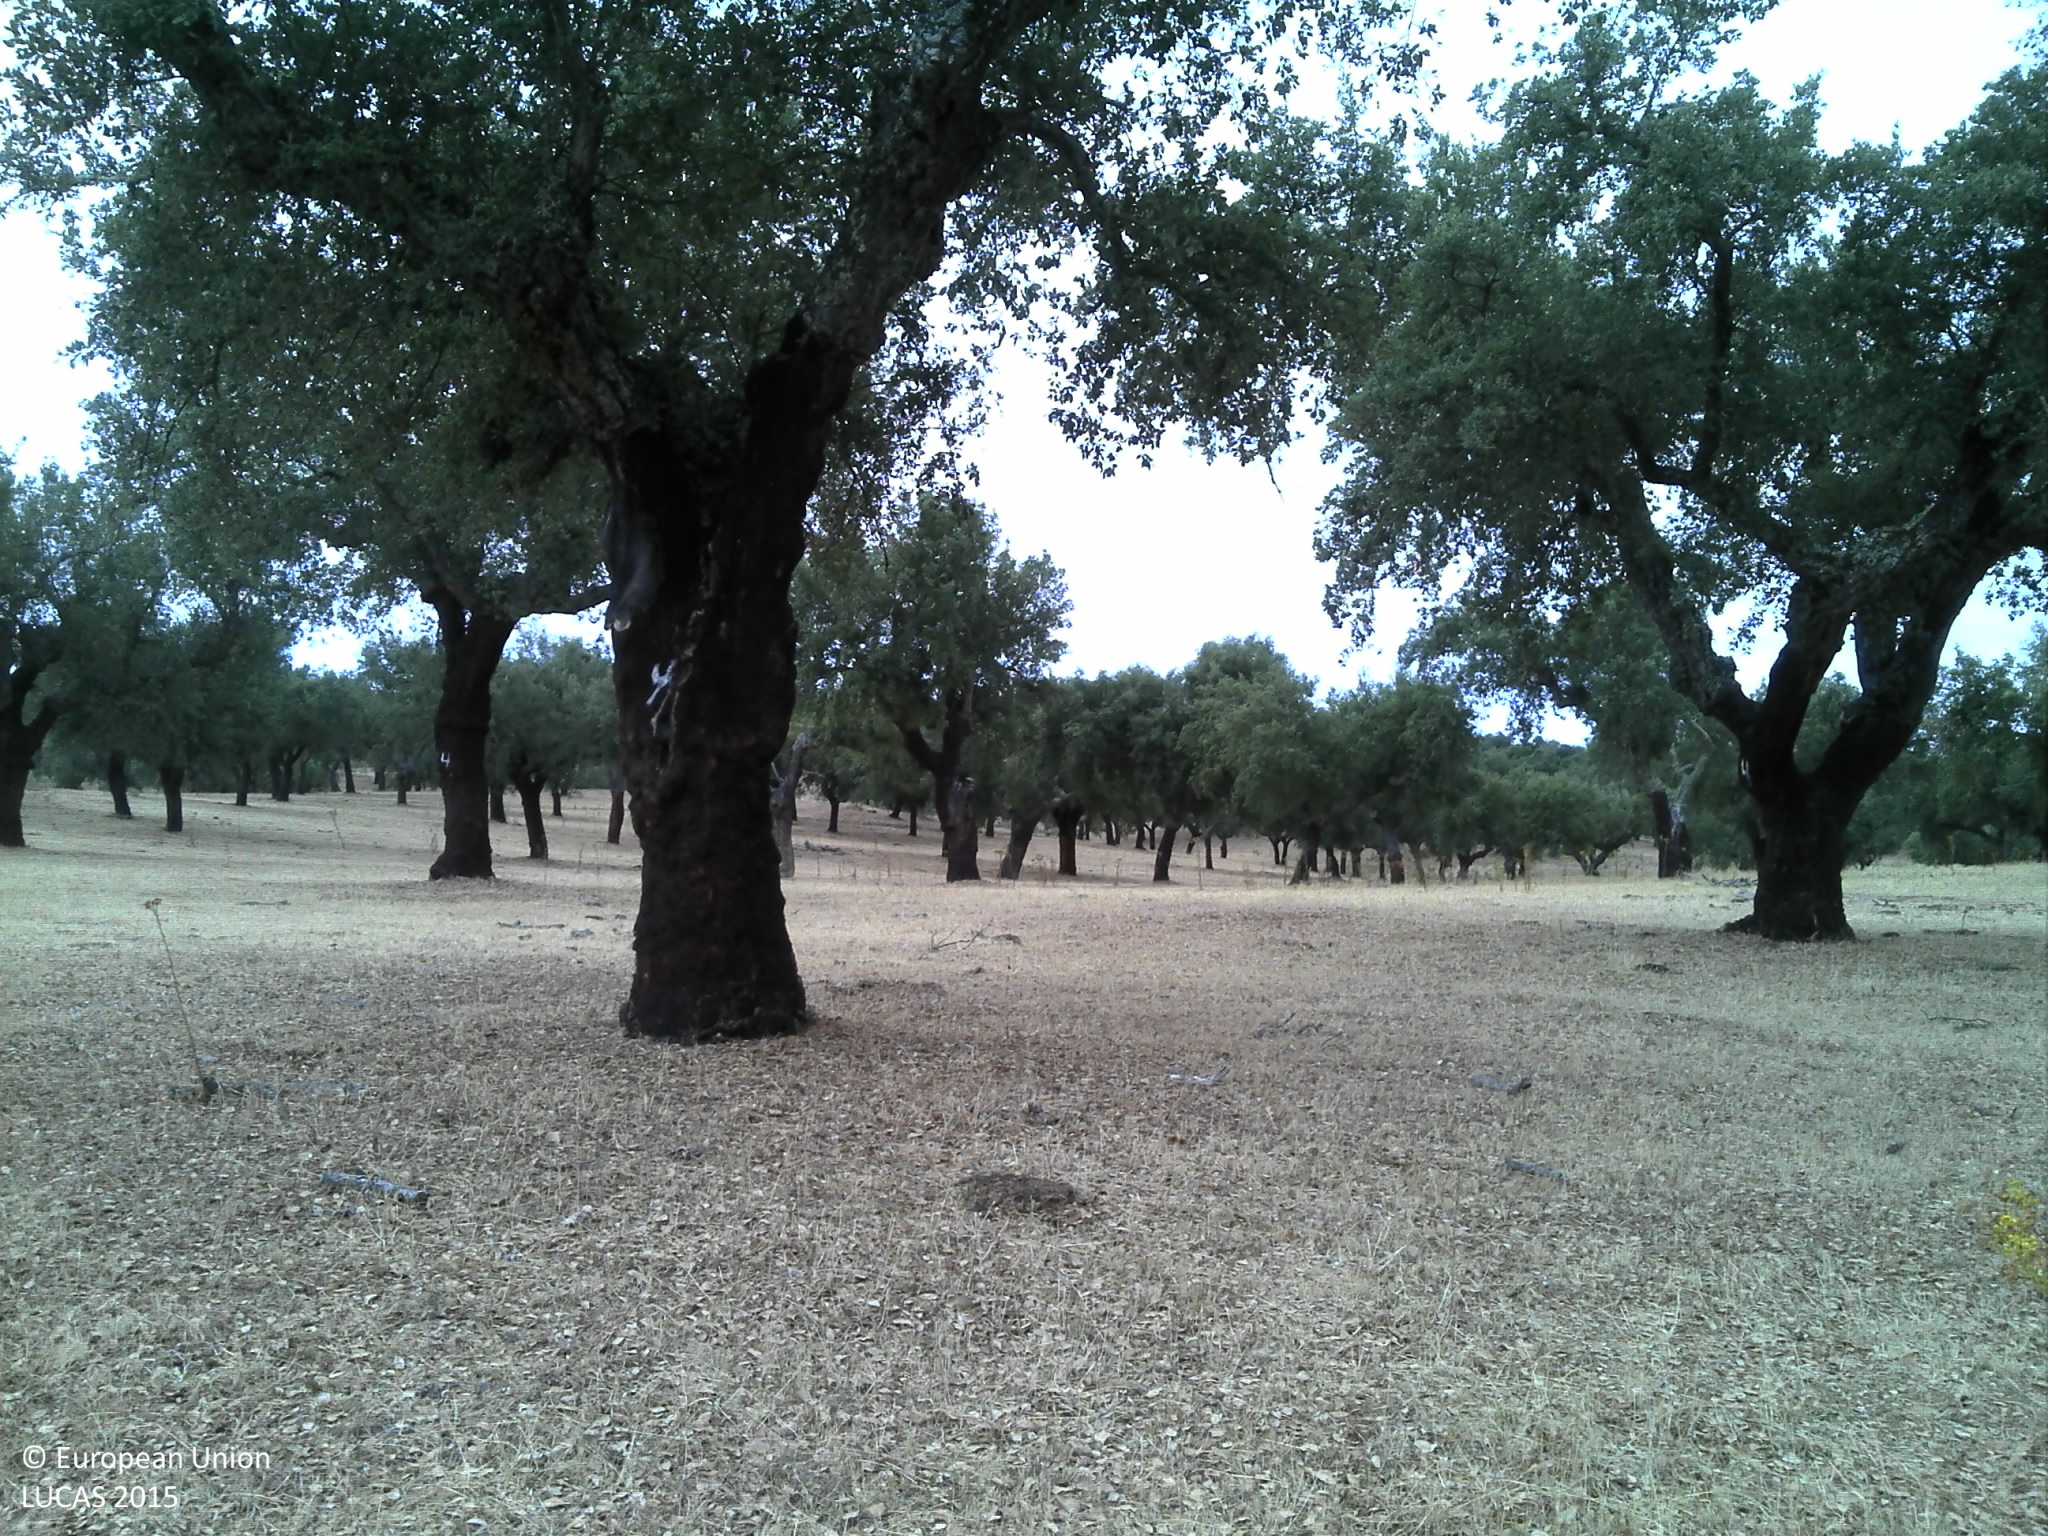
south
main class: Woodland
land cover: Broadleaved woodland
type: broadleaved evergreen forest
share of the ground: 25 - 50 %
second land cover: Grassland without tree/shrub cover
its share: 10 - 25 %
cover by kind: unconsolidated bare surface 60 %, broadleaved forest trees 30 %, herbaceous plants 10 %
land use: Forestry
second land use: Agriculture (excluding fallow land and kitchen gardens)
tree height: > 5 m
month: July
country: PT
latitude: 39.2251
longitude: -7.4507
